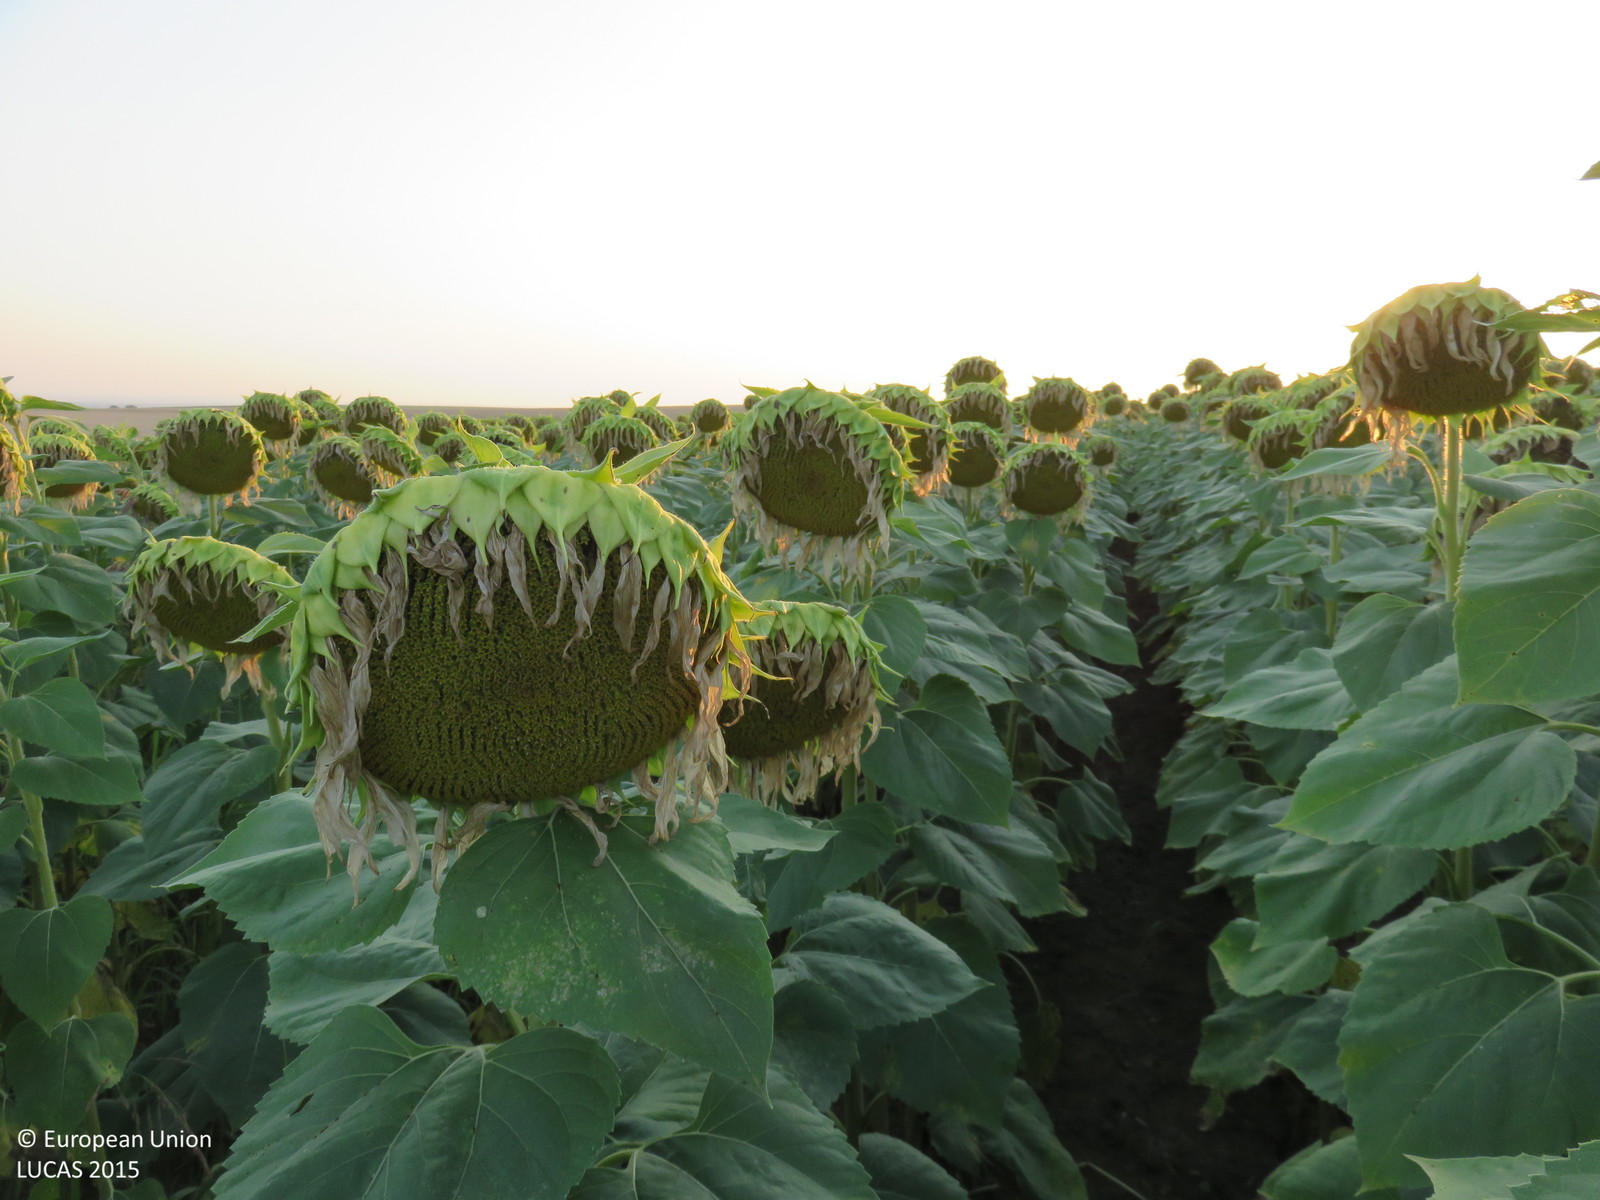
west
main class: Cropland
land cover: Sunflower
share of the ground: > 75 %
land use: Agriculture (excluding fallow land and kitchen gardens)
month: July
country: BG
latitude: 43.4808
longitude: 25.0694
